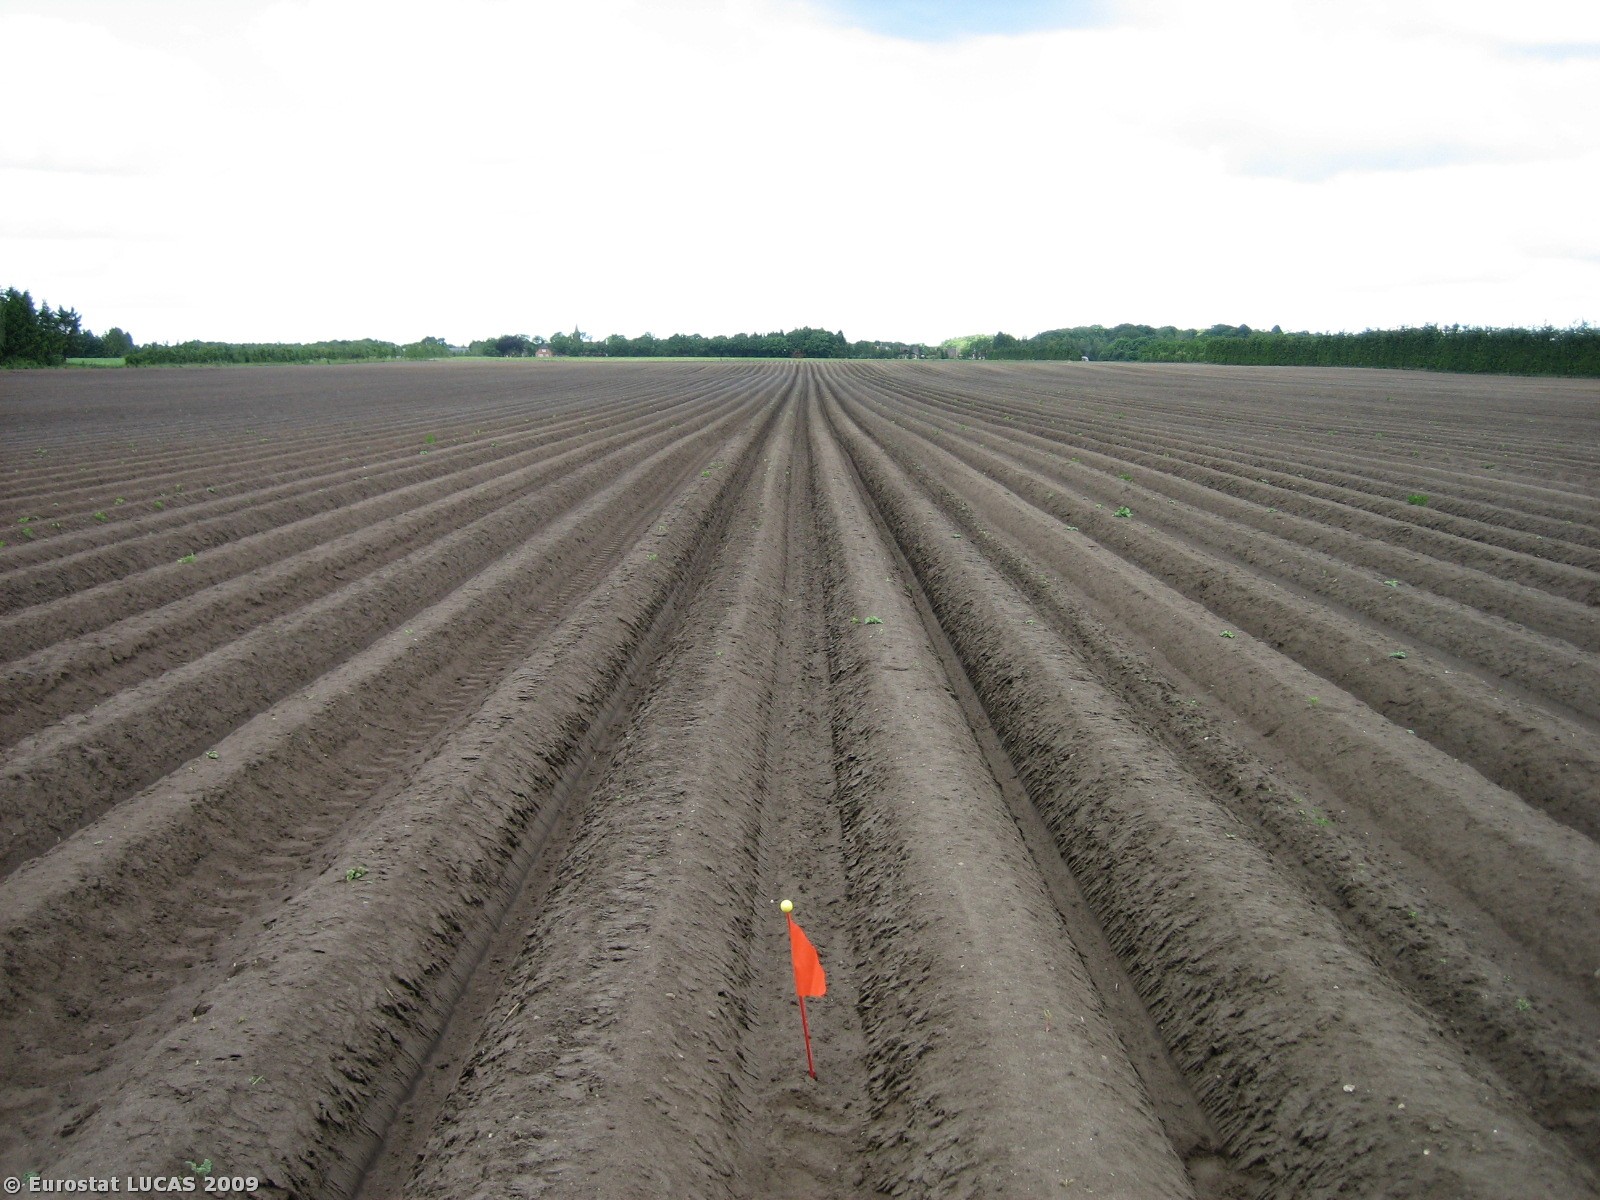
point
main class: Cropland
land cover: Potatoes
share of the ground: < 10 %
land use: Agriculture (excluding fallow land and kitchen gardens)
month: June
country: DK
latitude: 56.0241
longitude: 9.3109
